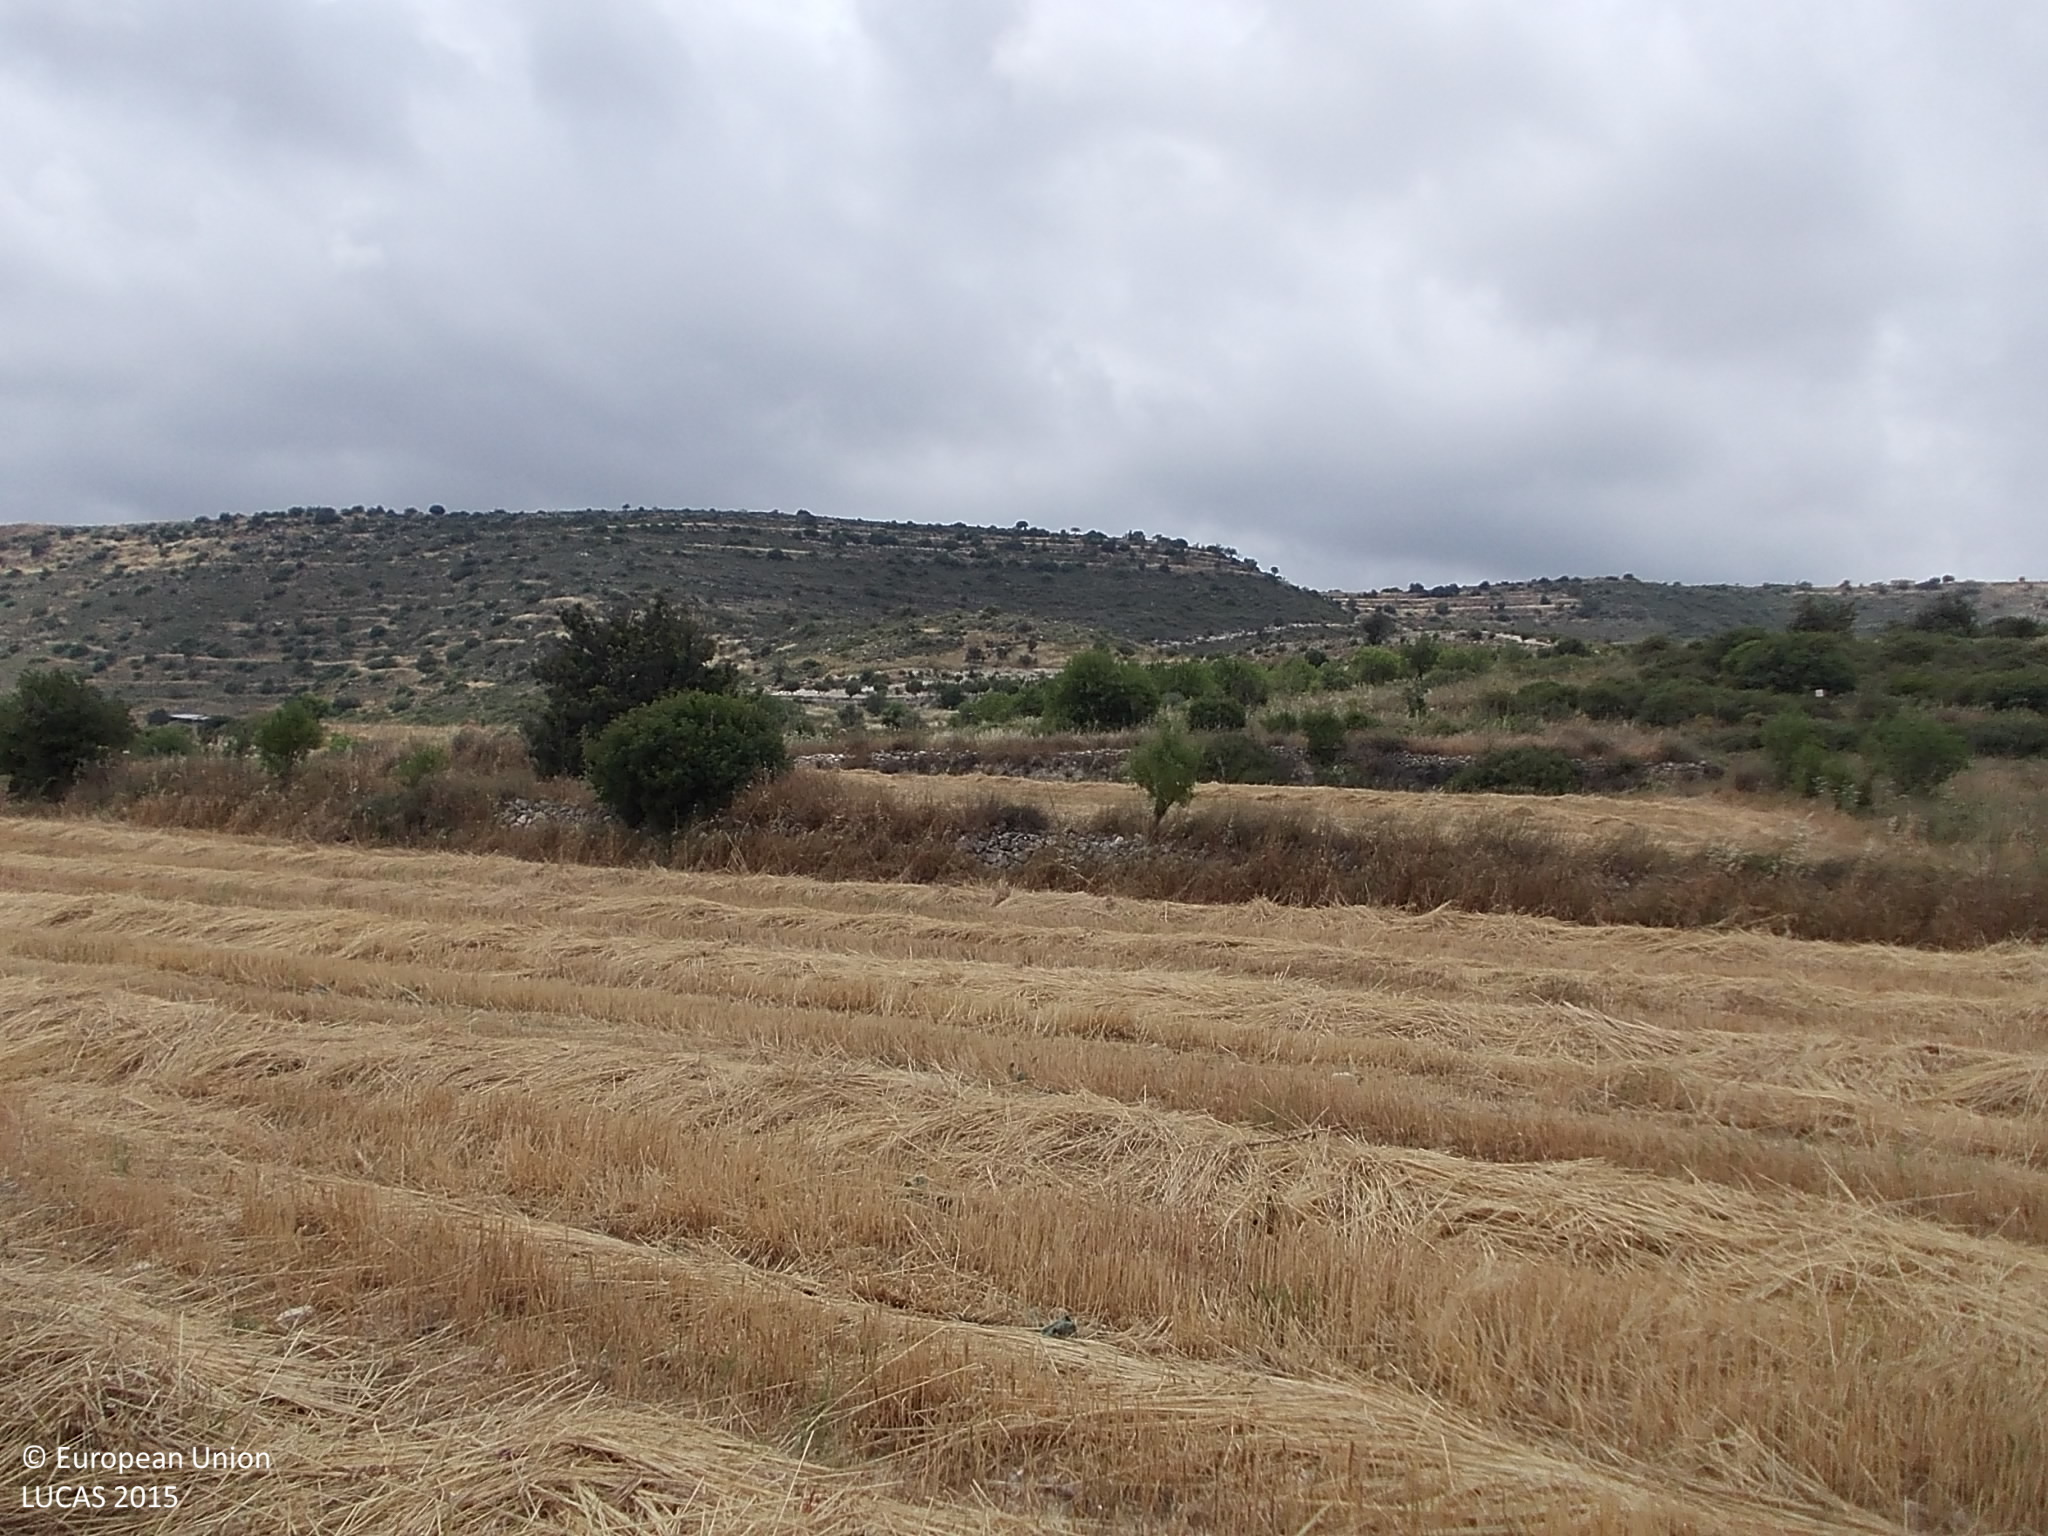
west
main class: Cropland
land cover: Oats
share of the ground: > 75 %
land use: Agriculture (excluding fallow land and kitchen gardens)
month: May
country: CY
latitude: 34.7678
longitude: 32.8083
